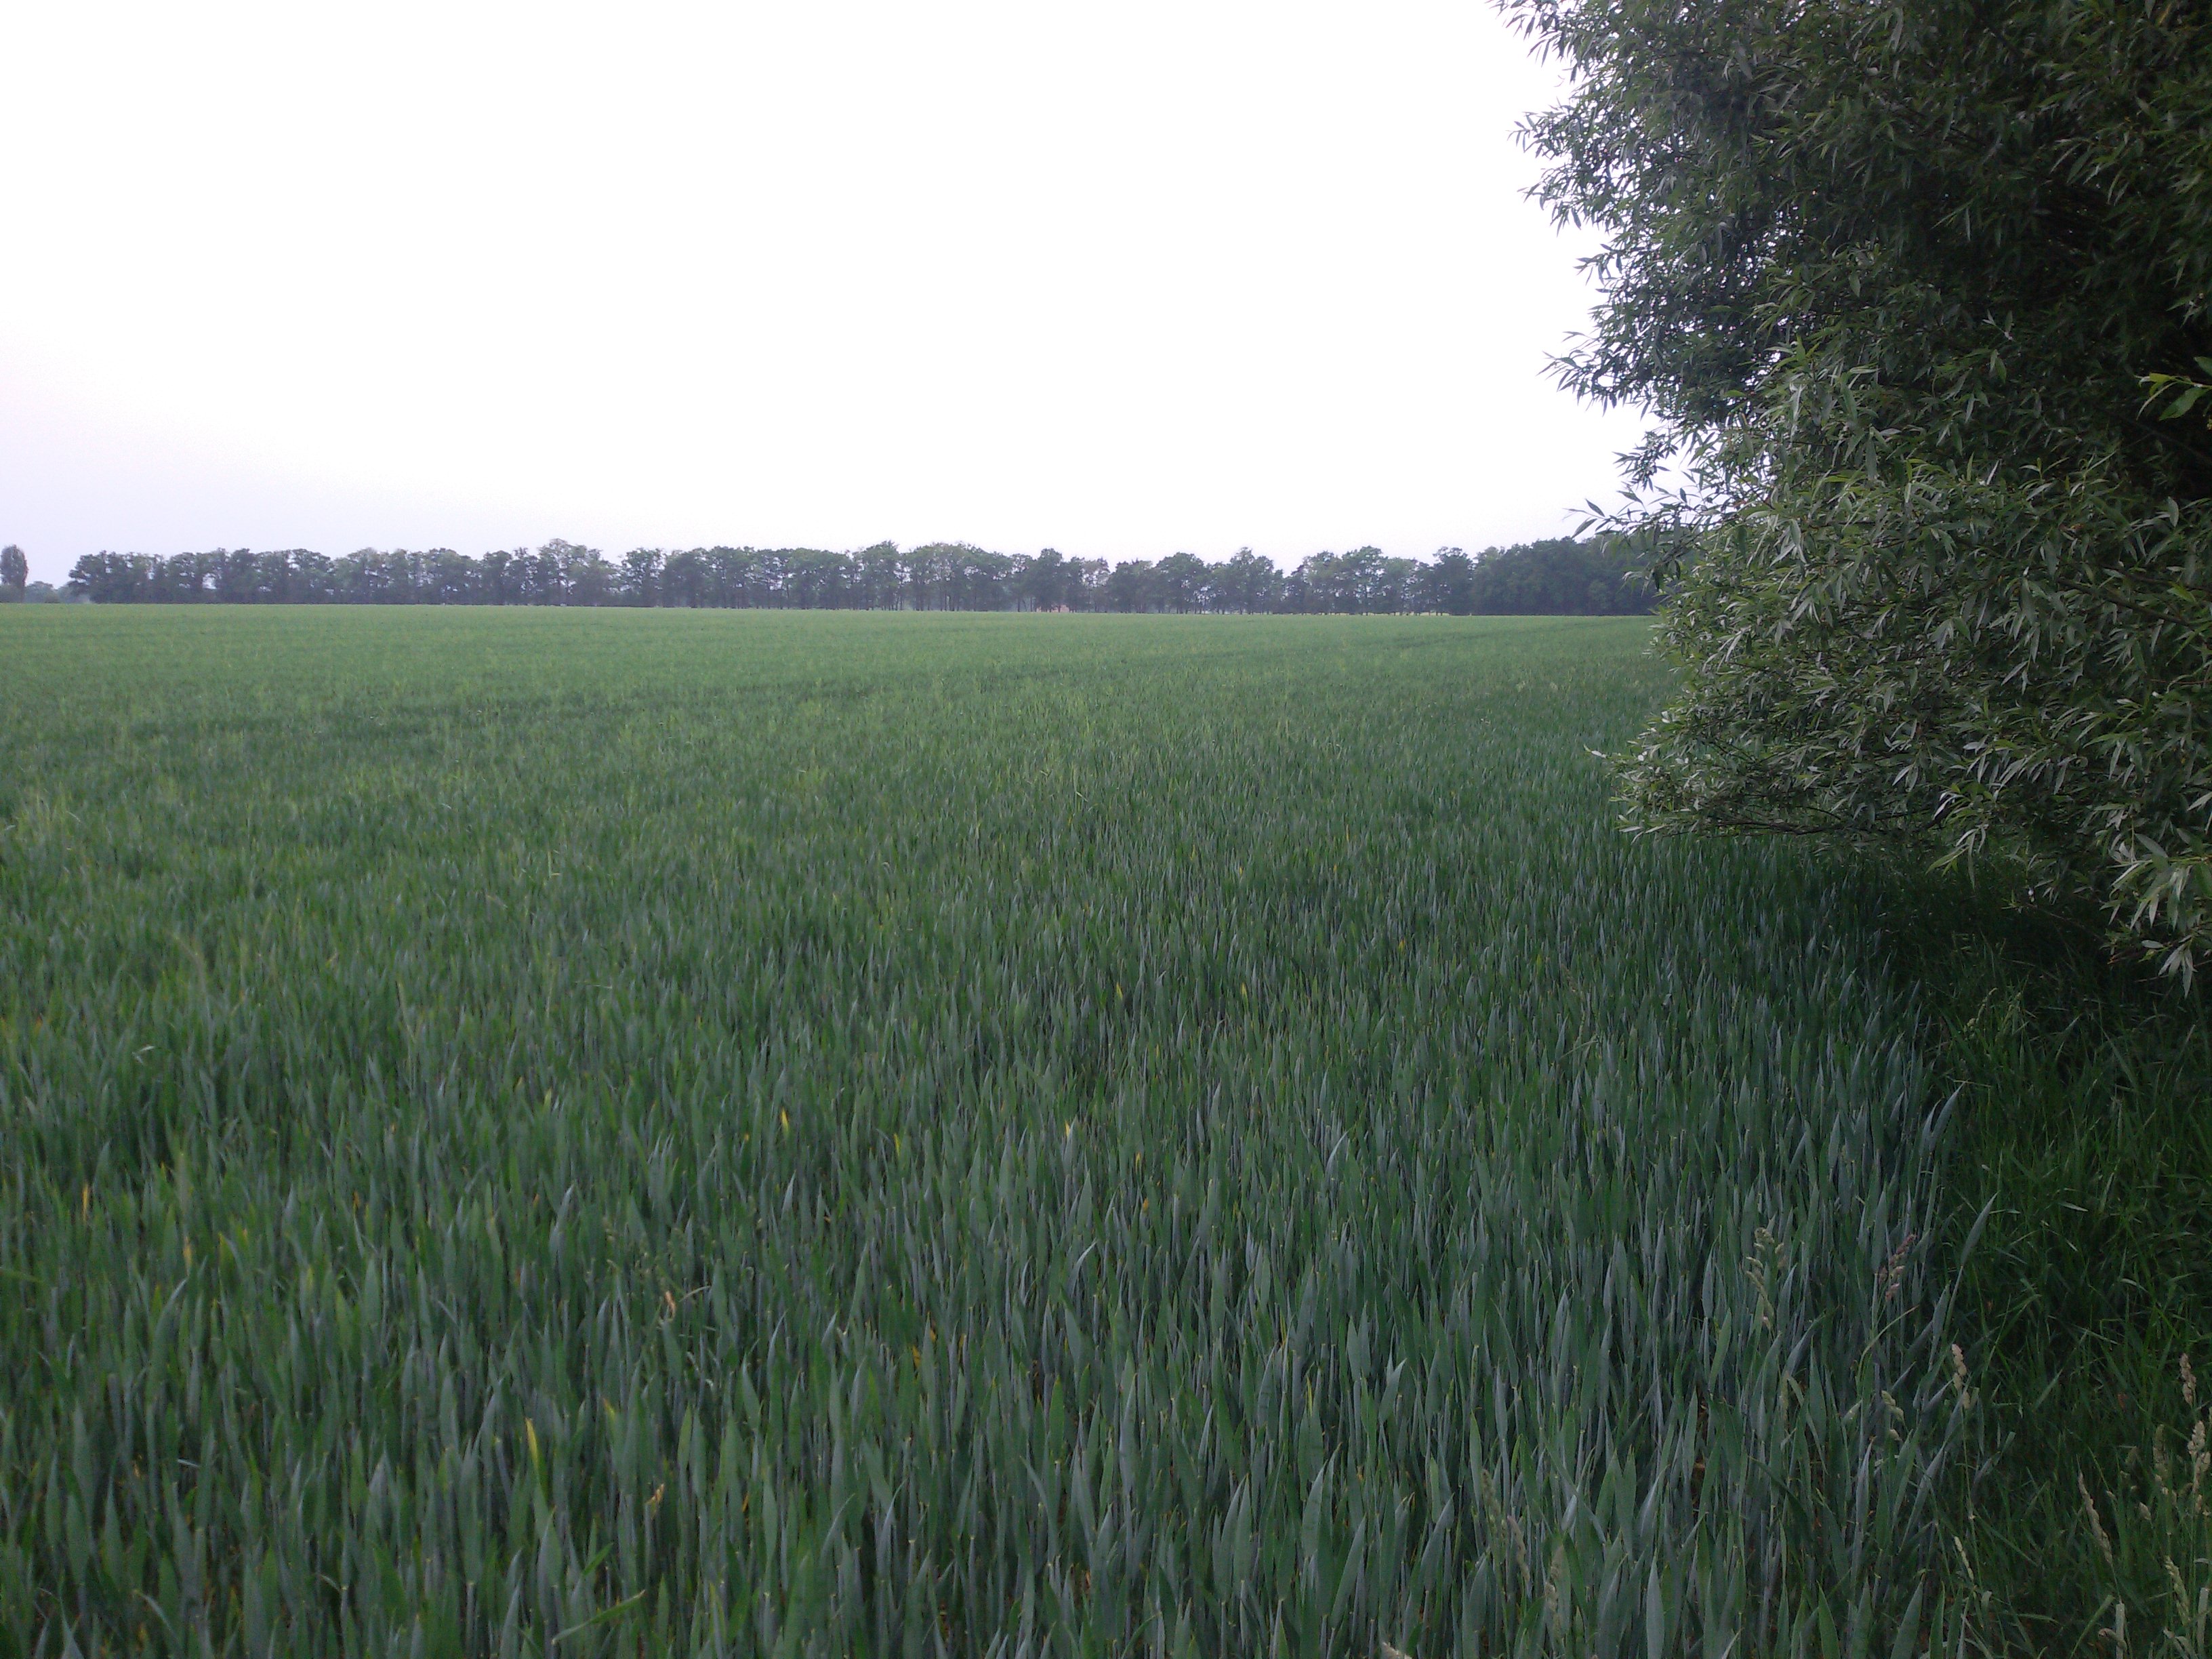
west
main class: Cropland
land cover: Common wheat
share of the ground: > 75 %
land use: Agriculture (excluding fallow land and kitchen gardens)
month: May
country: PL
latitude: 52.1428
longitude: 16.8625
